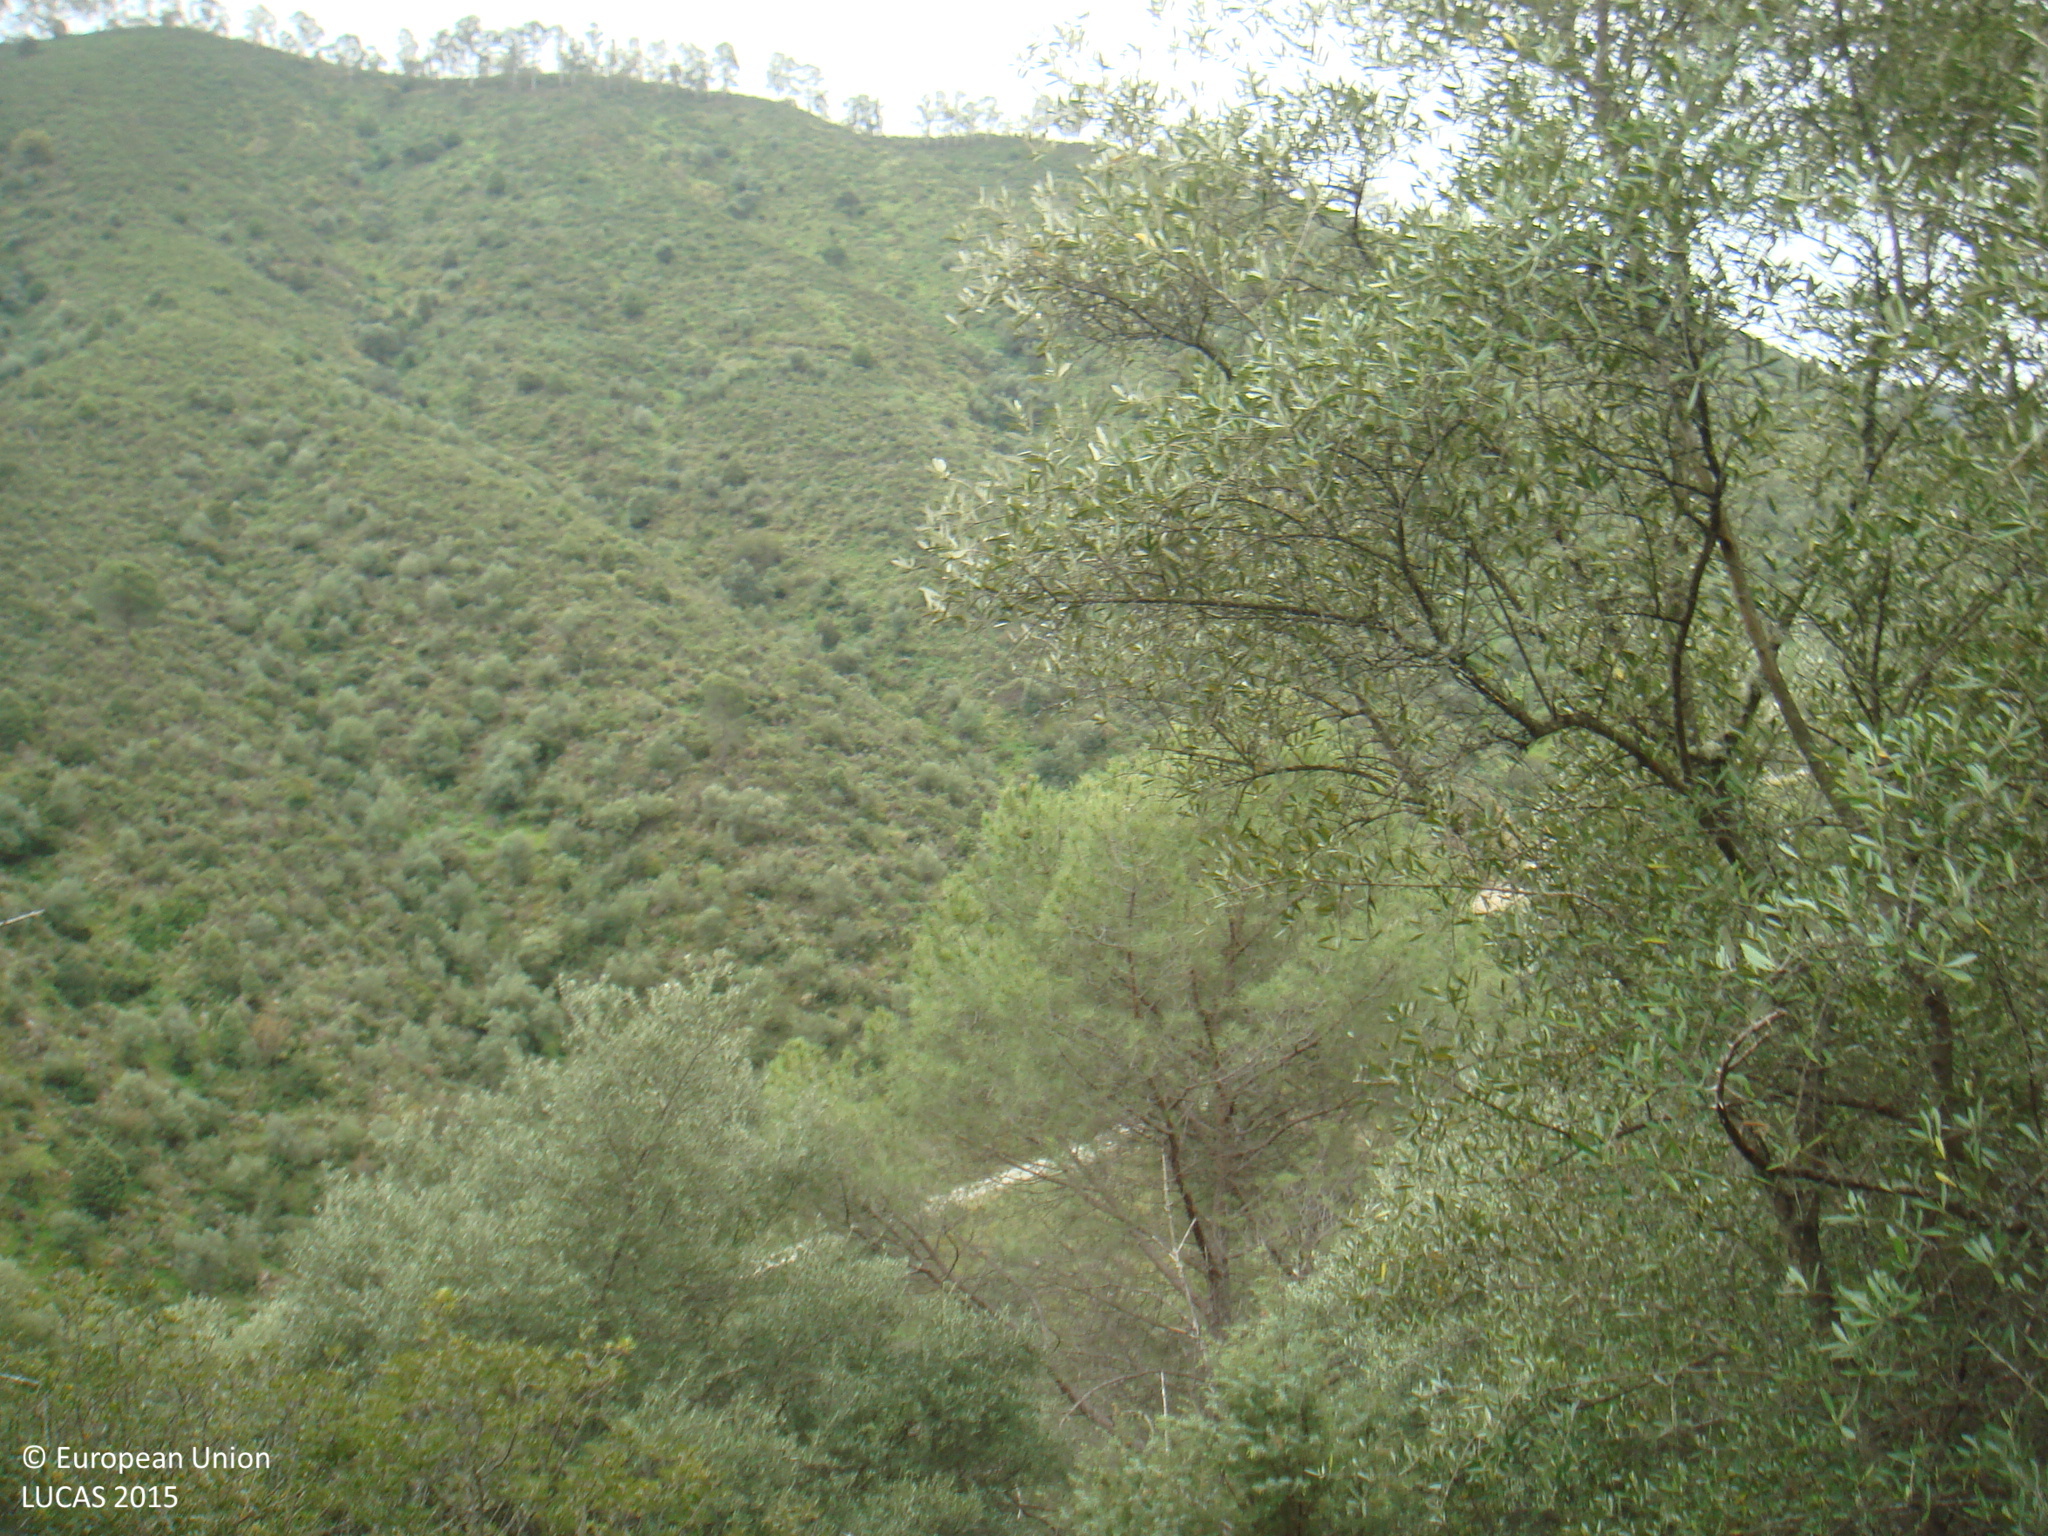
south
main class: Shrubland
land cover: Shrubland with sparse tree cover
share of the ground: 10 - 25 %
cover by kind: shrubs 55 %, herbaceous plants 40 %, broadleaved forest trees 5 %
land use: Forestry
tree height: < 5 m
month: April
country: ES
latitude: 38.0046
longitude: -5.2266
